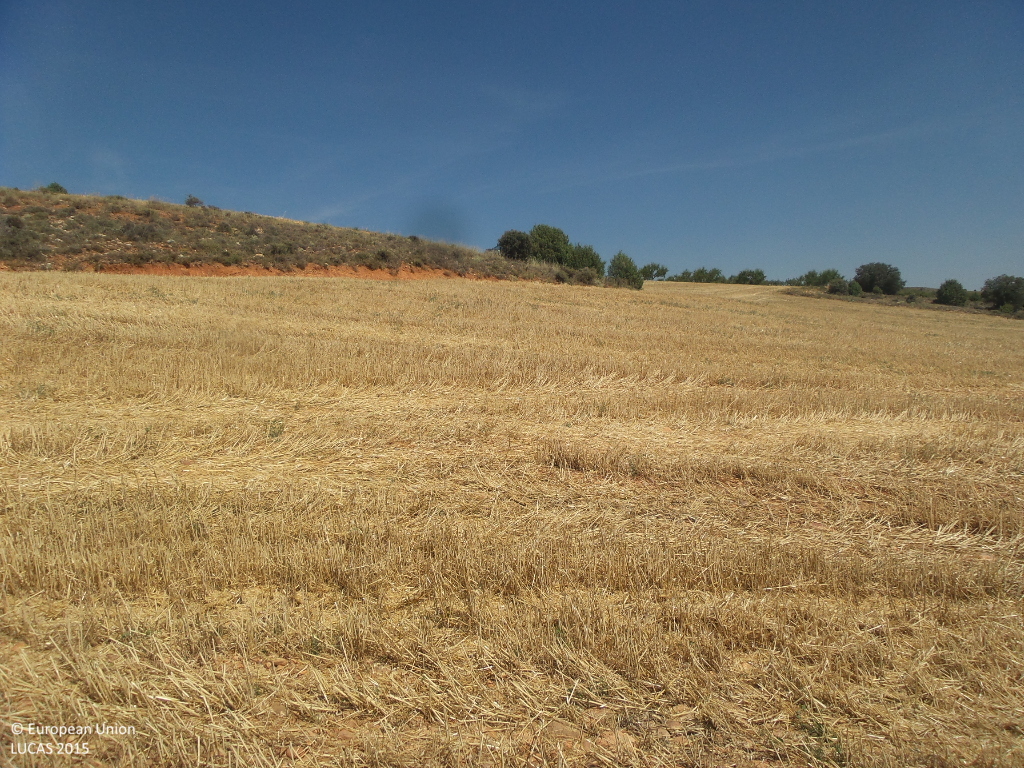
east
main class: Cropland
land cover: Common wheat
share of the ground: < 10 %
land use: Agriculture (excluding fallow land and kitchen gardens)
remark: Harvested field
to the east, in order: Common wheat; Shrubland with sparse tree cover; Common wheat; Nuts trees
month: July
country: ES
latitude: 41.2208
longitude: -1.8950
